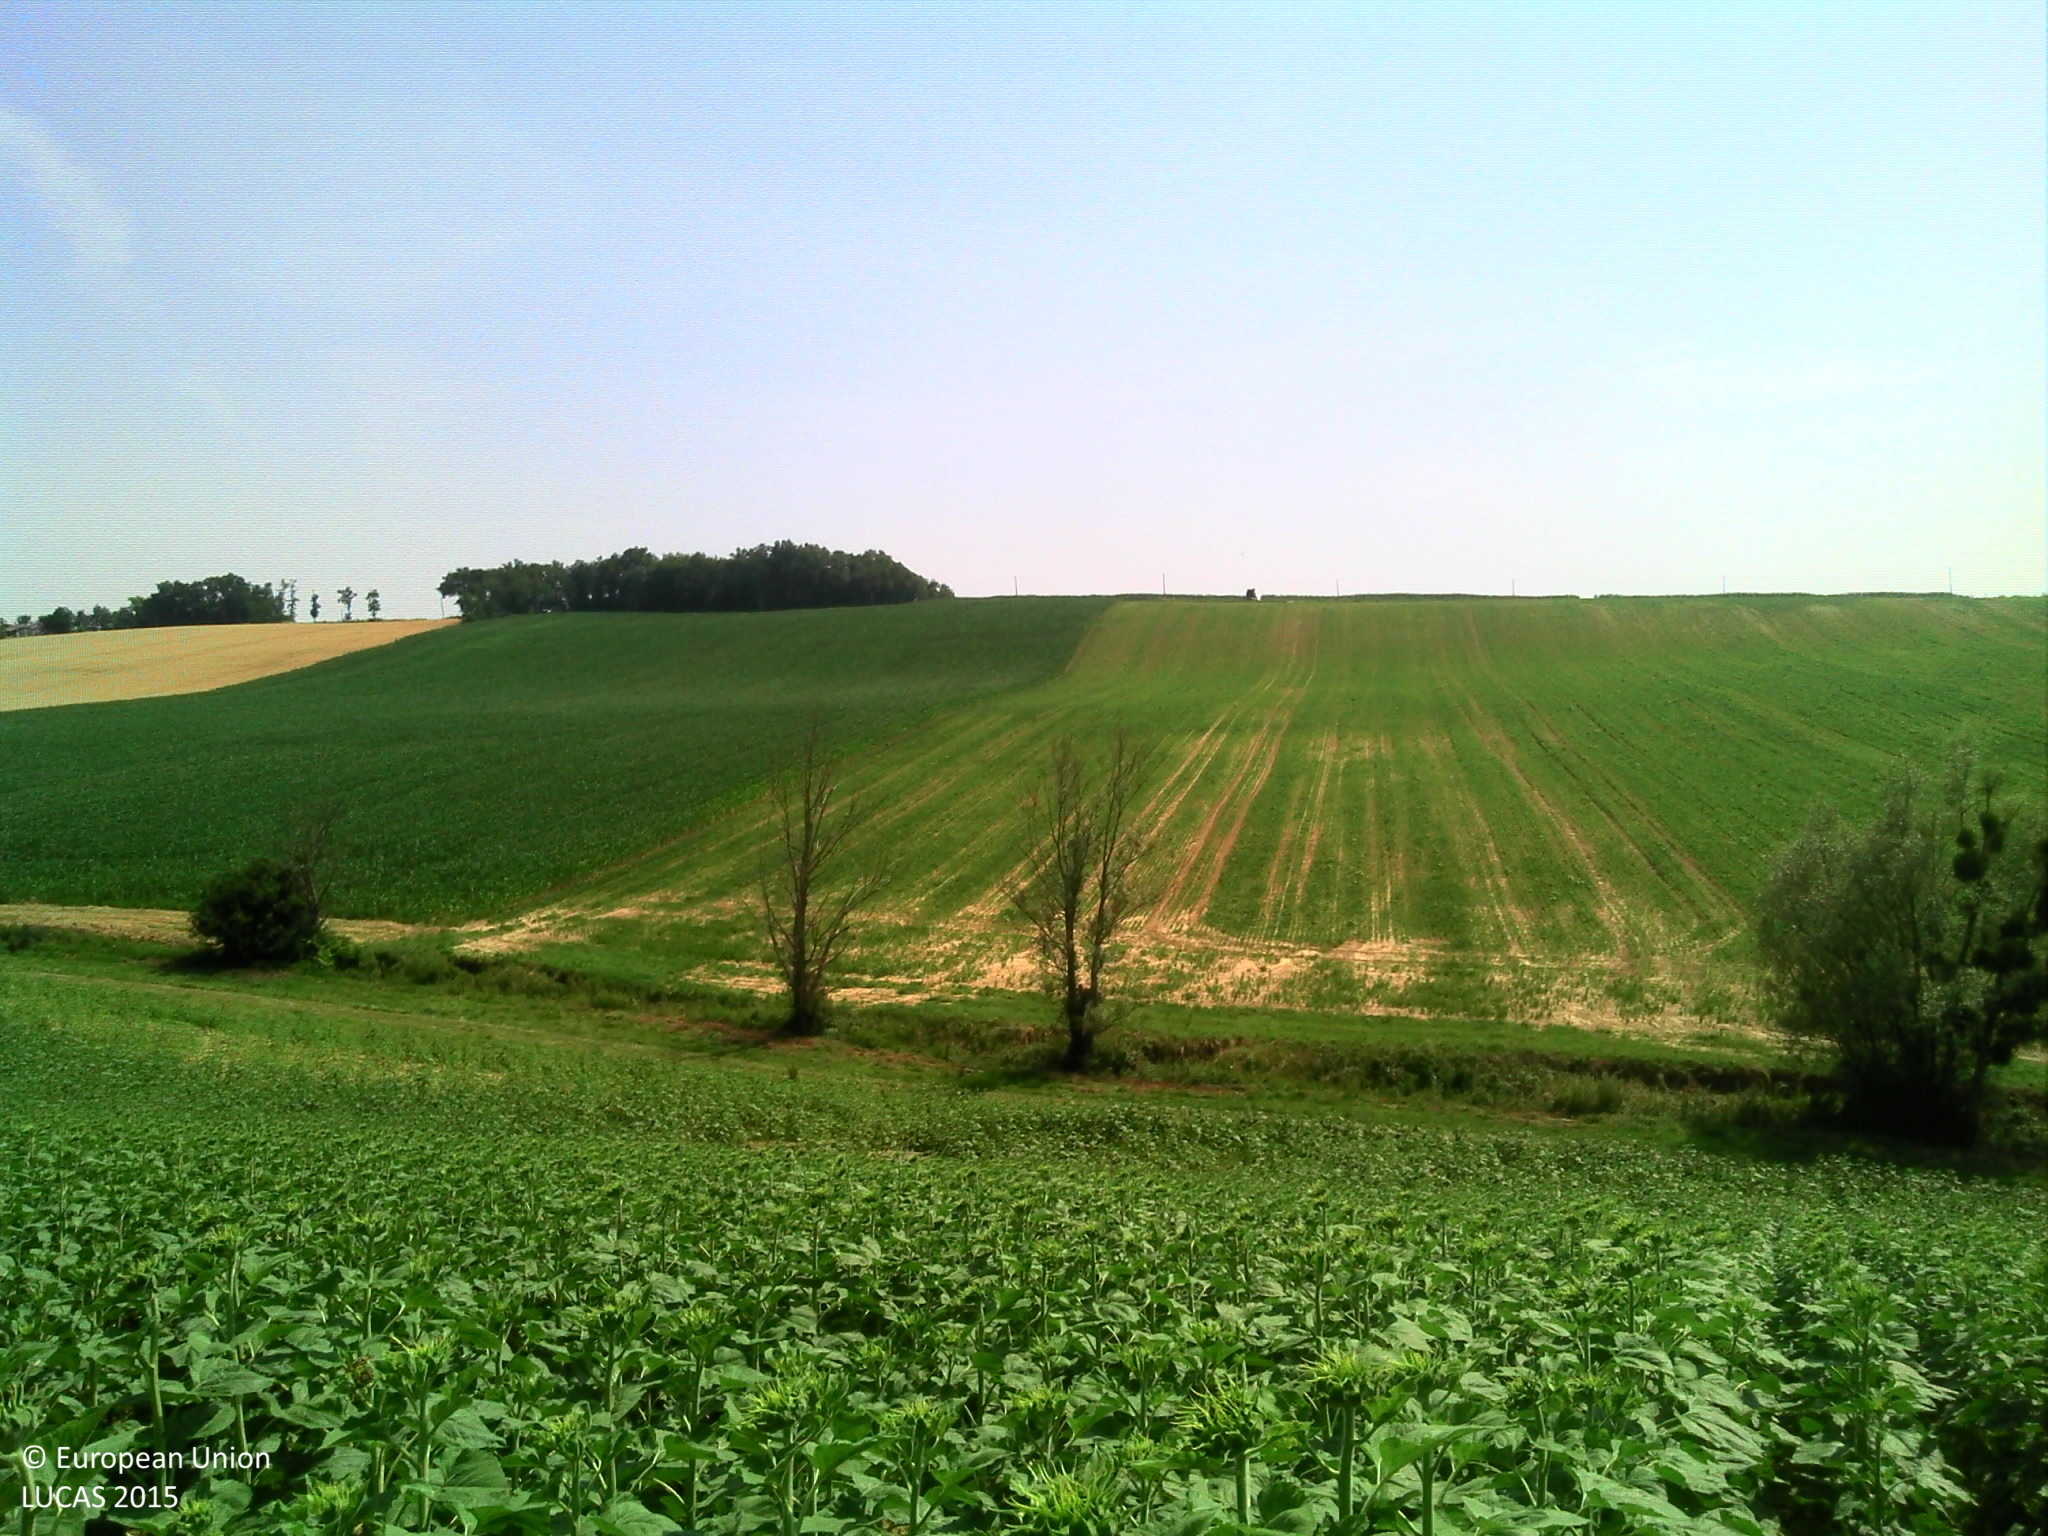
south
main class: Cropland
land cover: Sunflower
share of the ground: > 75 %
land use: Agriculture (excluding fallow land and kitchen gardens)
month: July
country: FR
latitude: 43.6856
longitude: 1.6292
